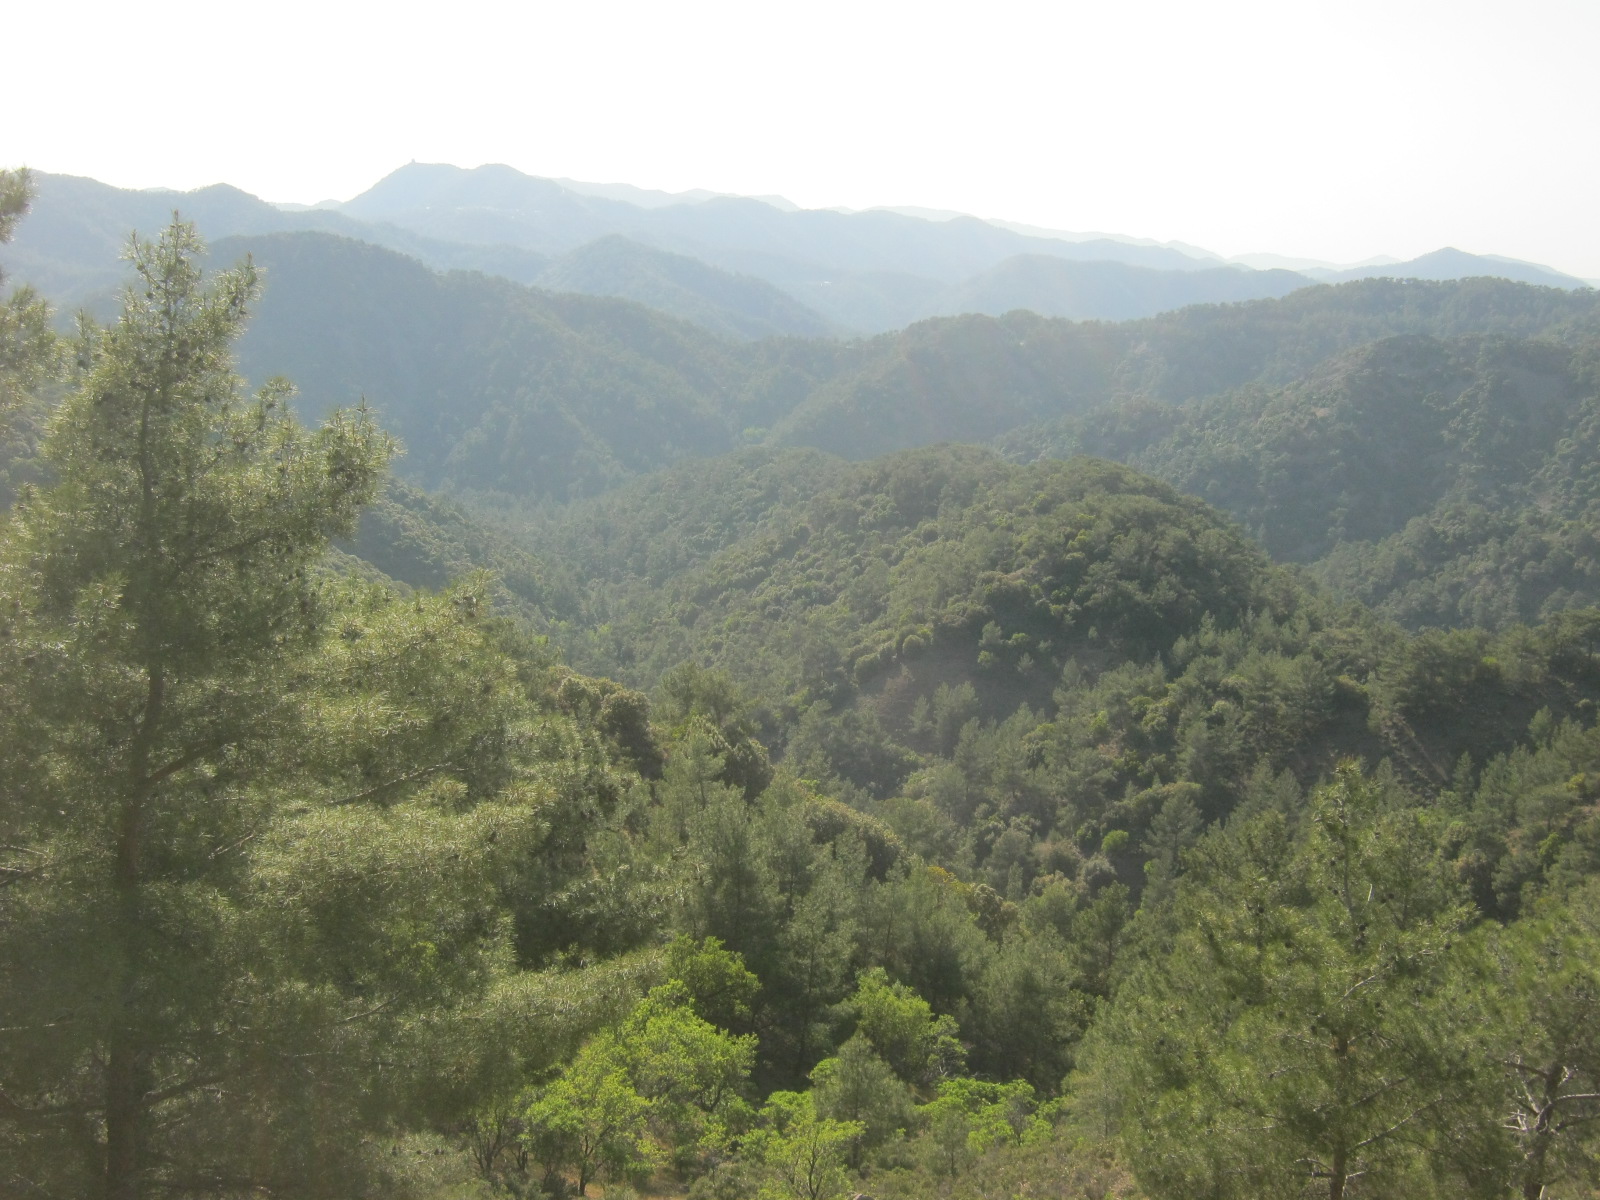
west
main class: Woodland
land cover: Pine dominated coniferous woodland
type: coniferous forest of the mediterranean region
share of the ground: > 75 %
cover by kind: coniferous forest trees 80 %, broadleaved forest trees 10 %, shrubs 10 %
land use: Semi-natural and natural areas not in use
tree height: > 5 m
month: May
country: CY
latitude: 34.9745
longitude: 32.8061
